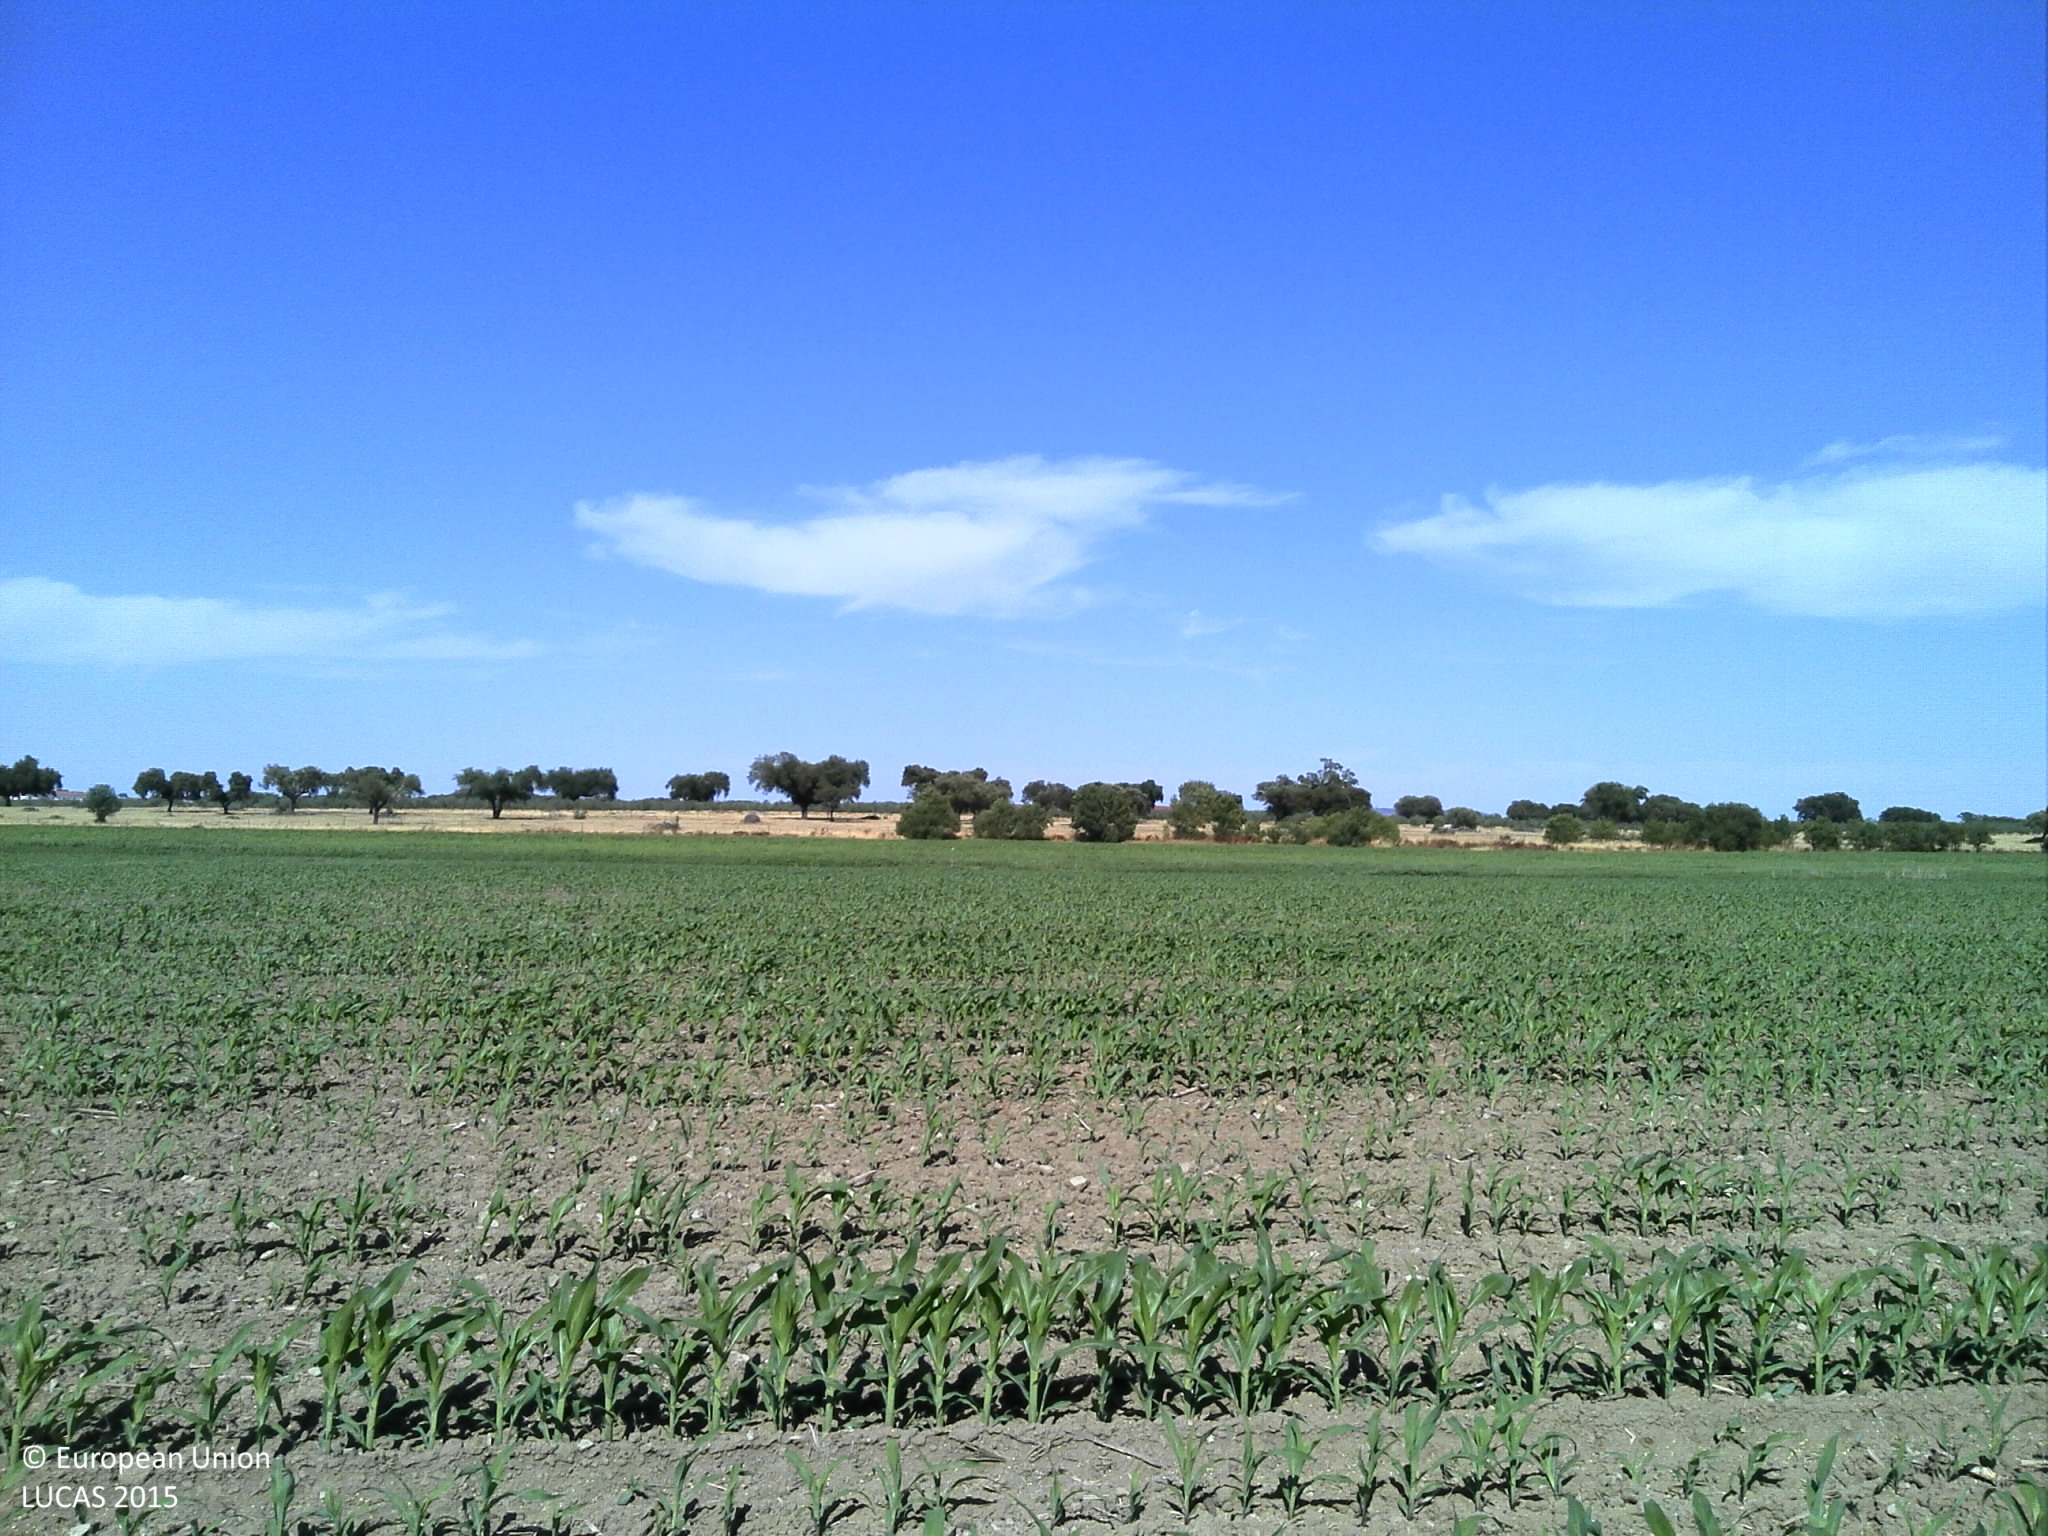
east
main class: Cropland
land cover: Maize
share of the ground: 10 - 25 %
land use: Agriculture (excluding fallow land and kitchen gardens)
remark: Temporary dry
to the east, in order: Maize; Rivers and streams; Spontaneously vegetated surfaces; Broadleaved woodland
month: June
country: PT
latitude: 38.3186
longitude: -8.1463
